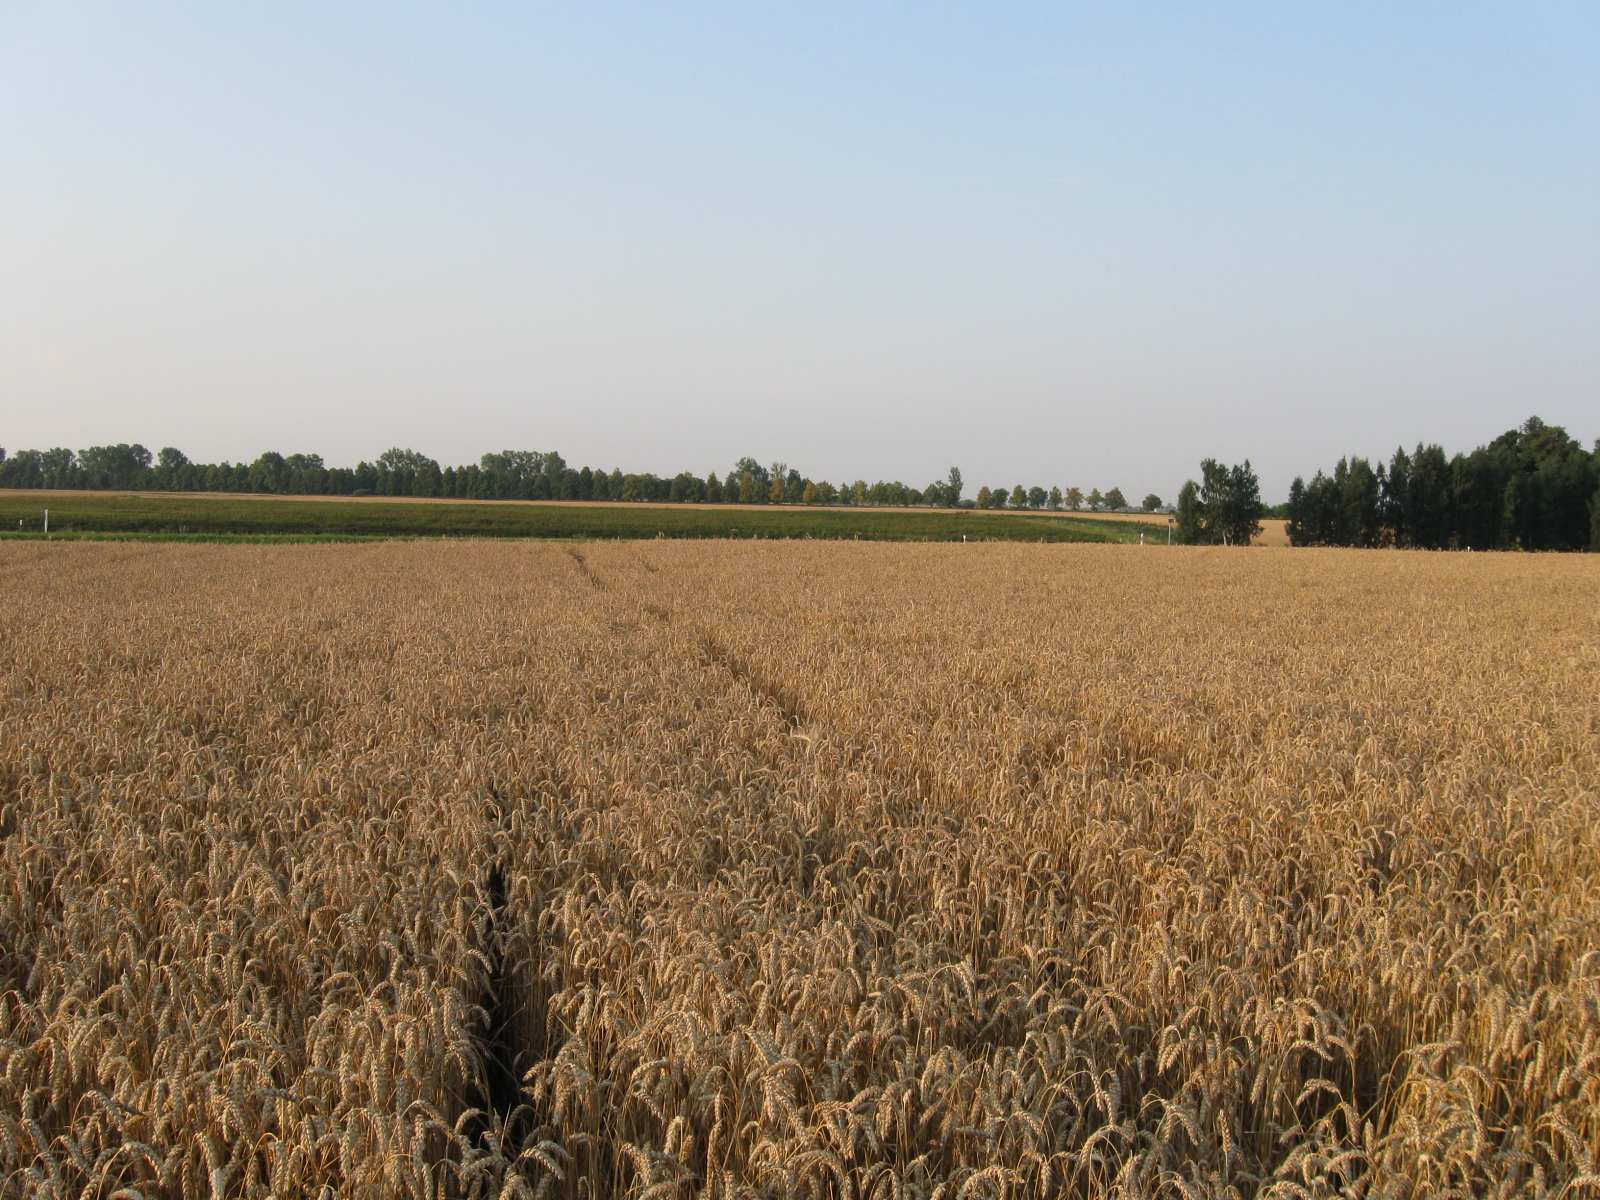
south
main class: Cropland
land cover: Common wheat
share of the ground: > 75 %
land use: Agriculture (excluding fallow land and kitchen gardens)
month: August
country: LT
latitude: 54.5784
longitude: 23.3057
